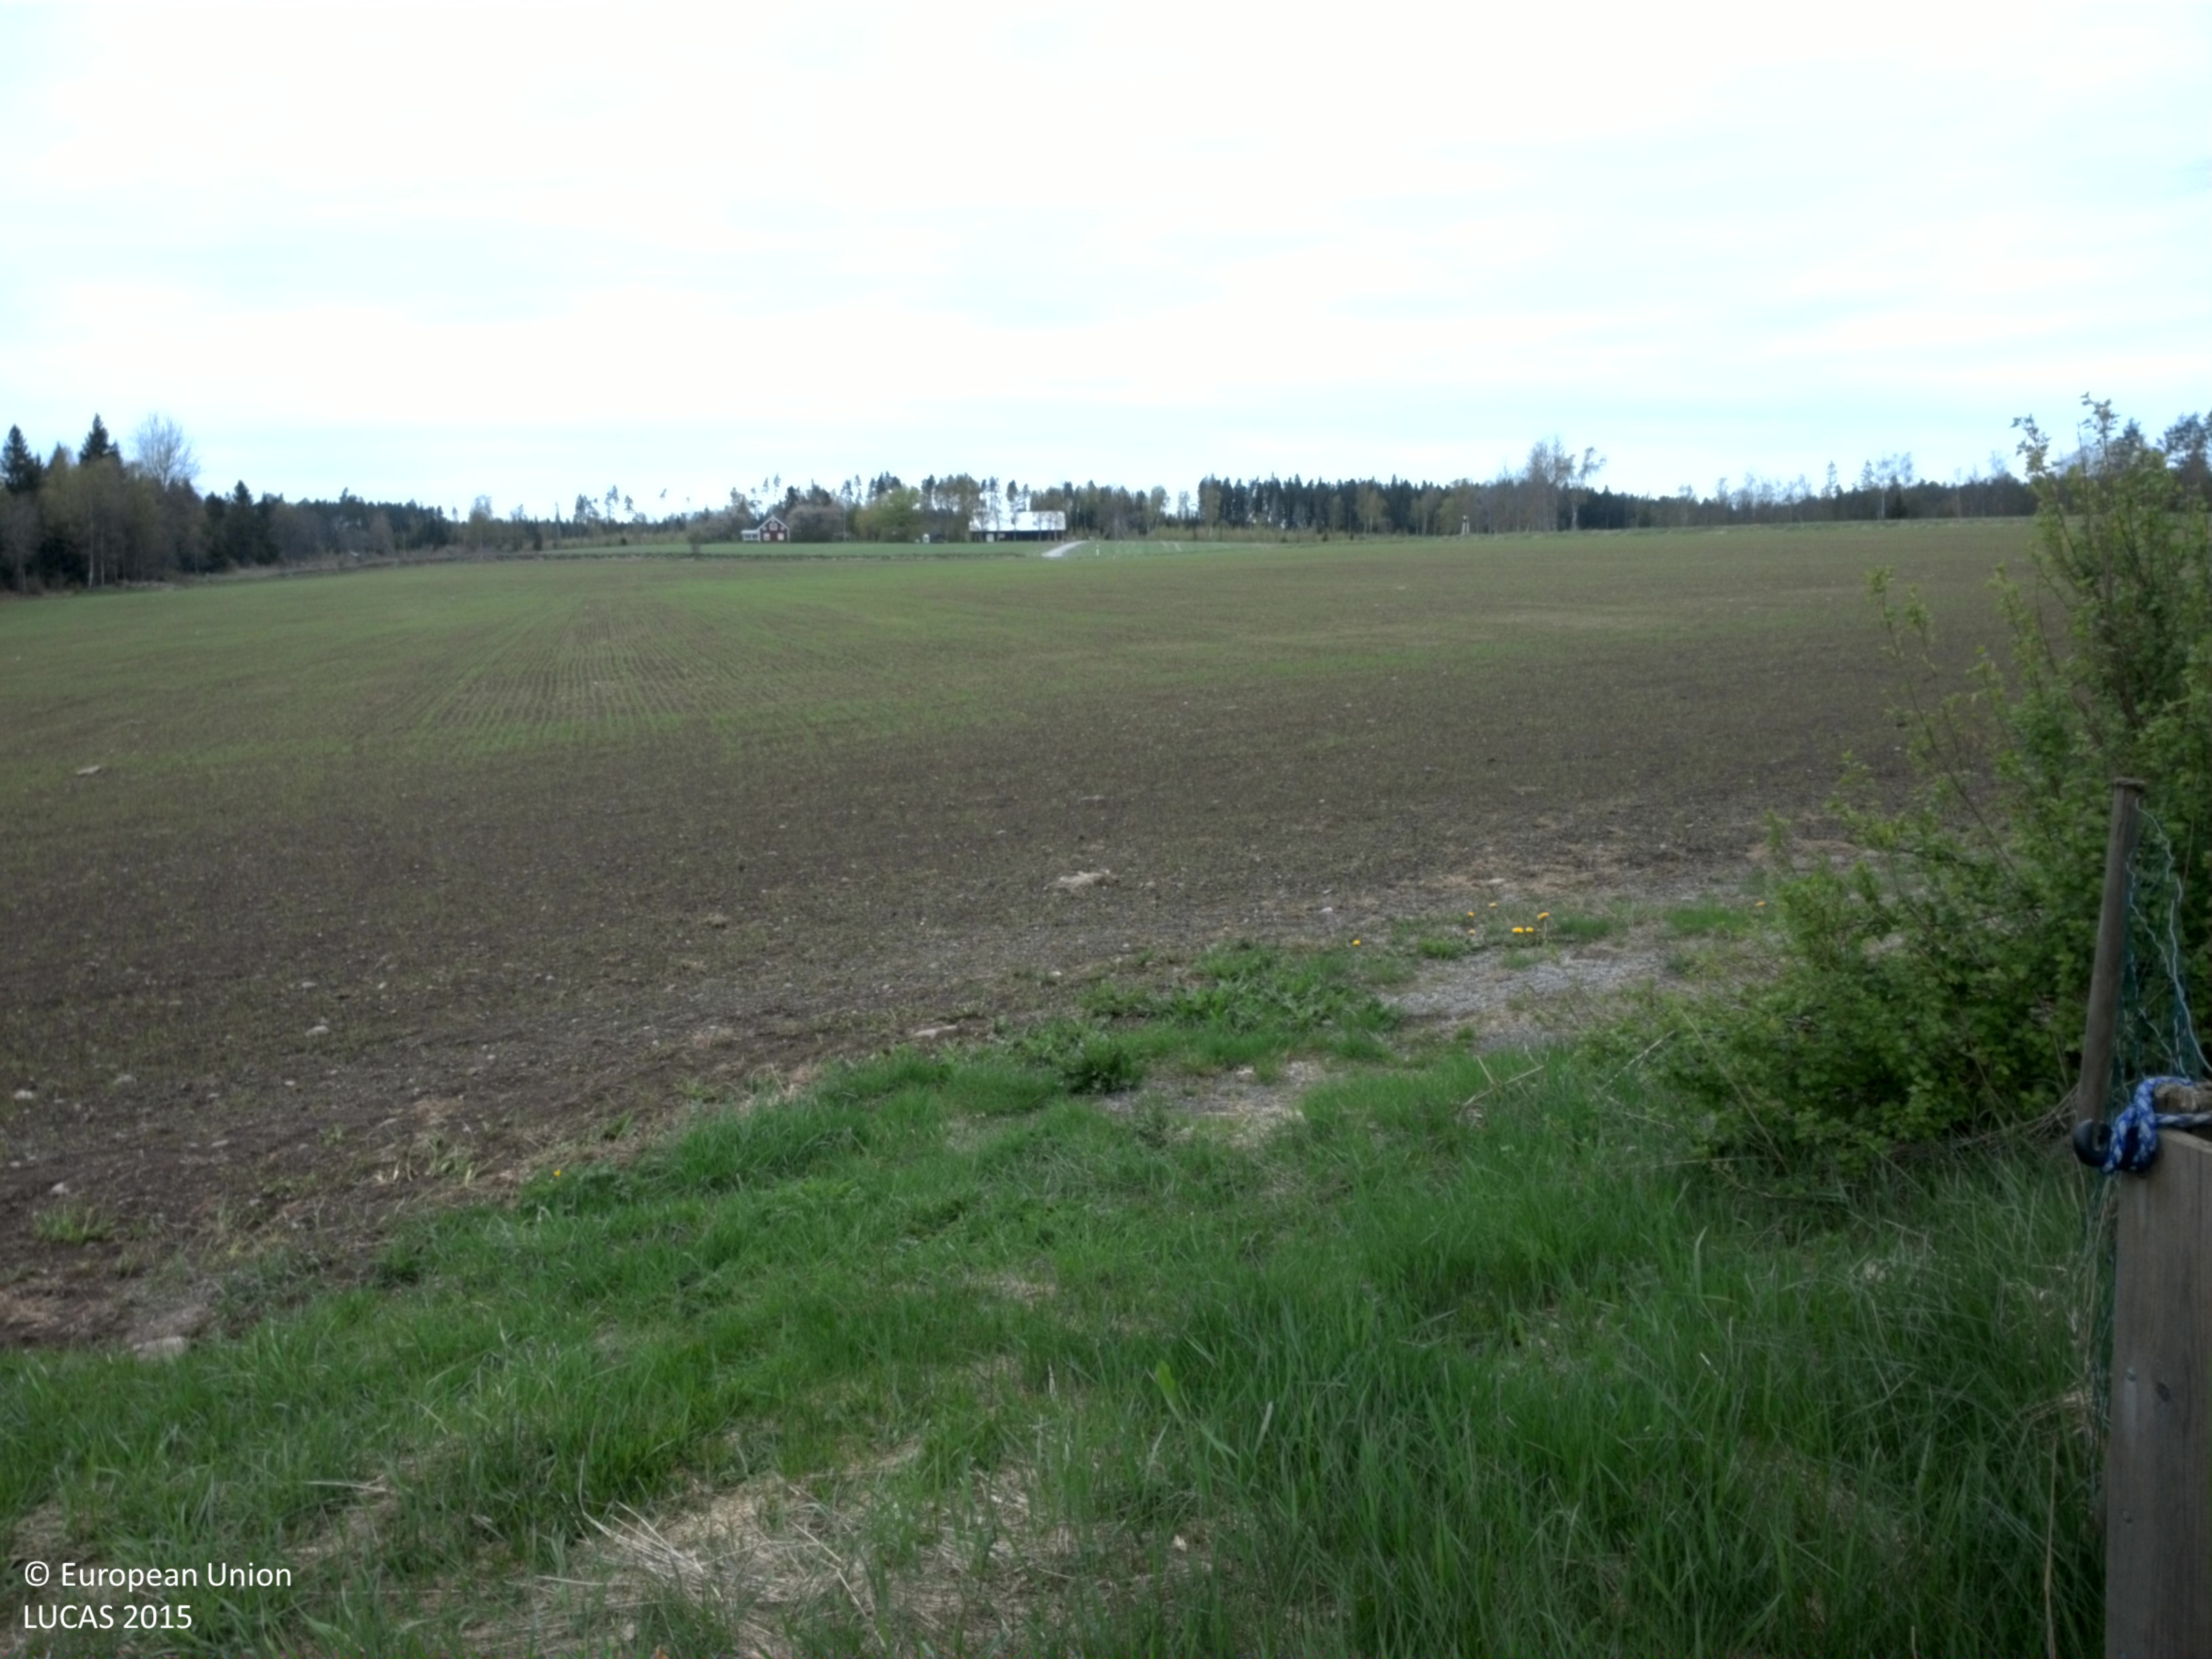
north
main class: Grassland
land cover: Grassland without tree/shrub cover
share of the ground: > 75 %
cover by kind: herbaceous plants 100 %
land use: Agriculture (excluding fallow land and kitchen gardens)
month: May
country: SE
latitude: 56.8210
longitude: 14.7322
